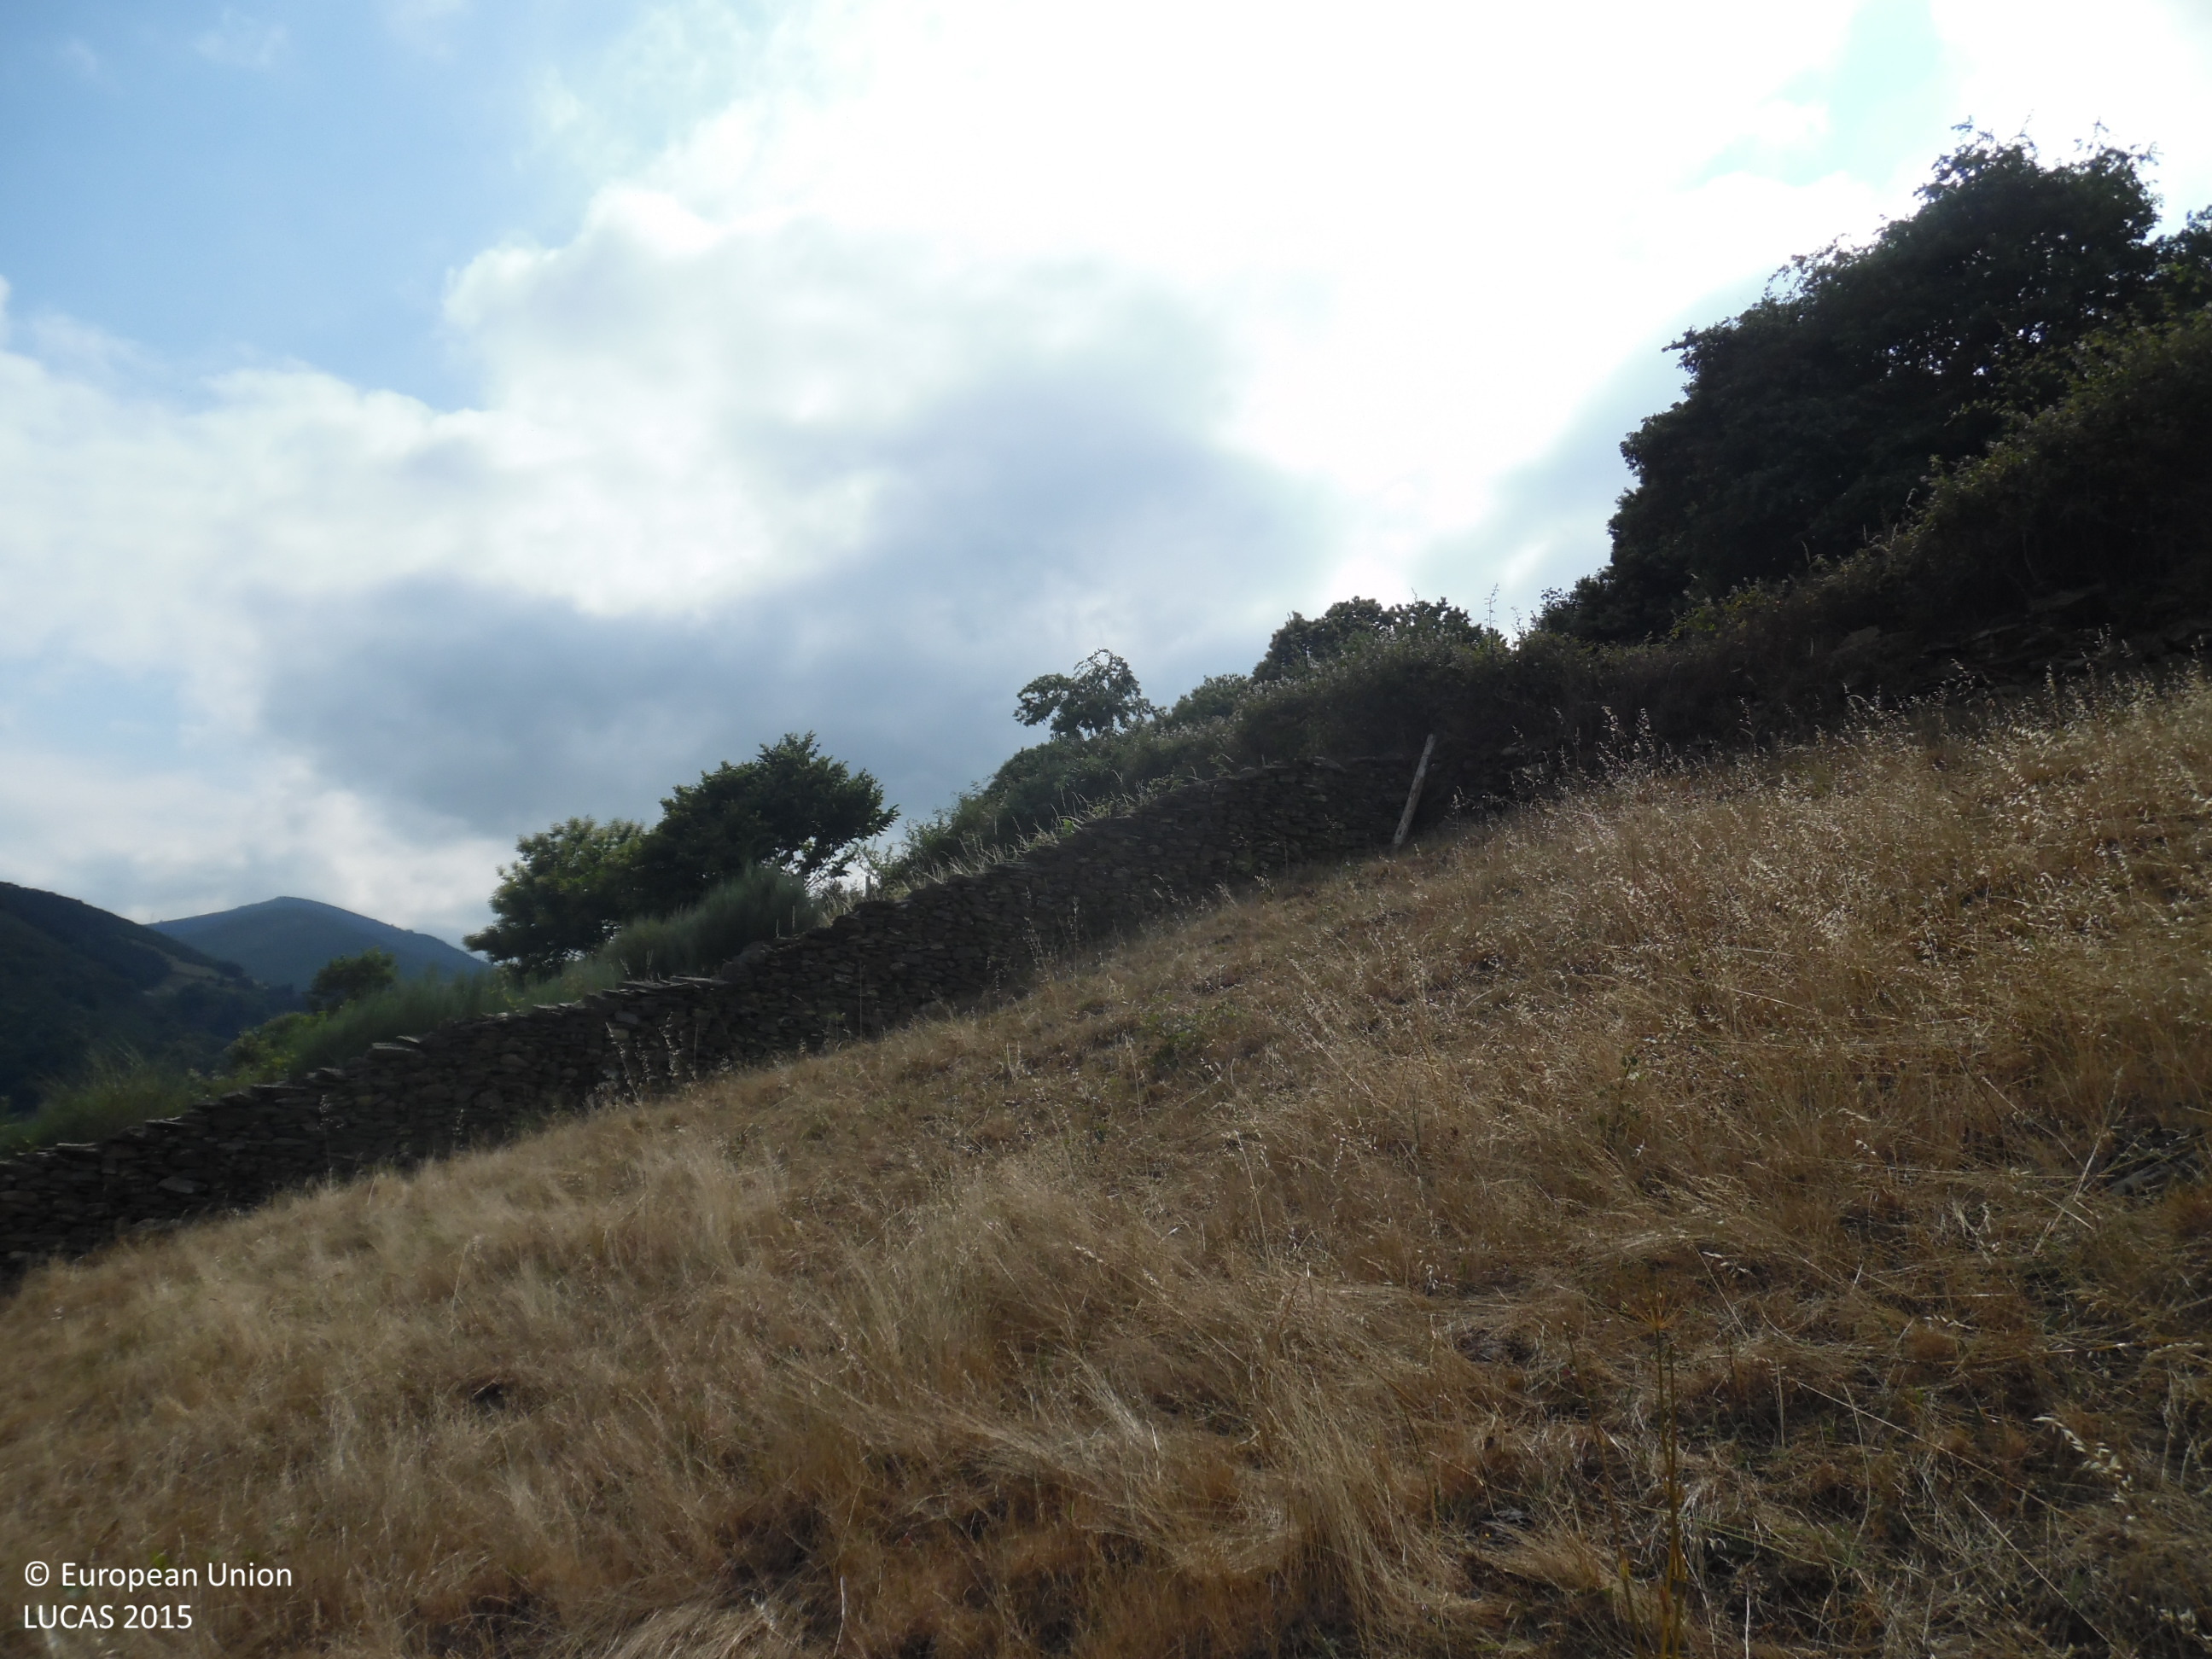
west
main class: Grassland
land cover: Grassland without tree/shrub cover
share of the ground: > 75 %
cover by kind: herbaceous plants 95 %, shrubs 5 %
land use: Agriculture (excluding fallow land and kitchen gardens)
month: July
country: ES
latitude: 43.1544
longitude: -6.5686
